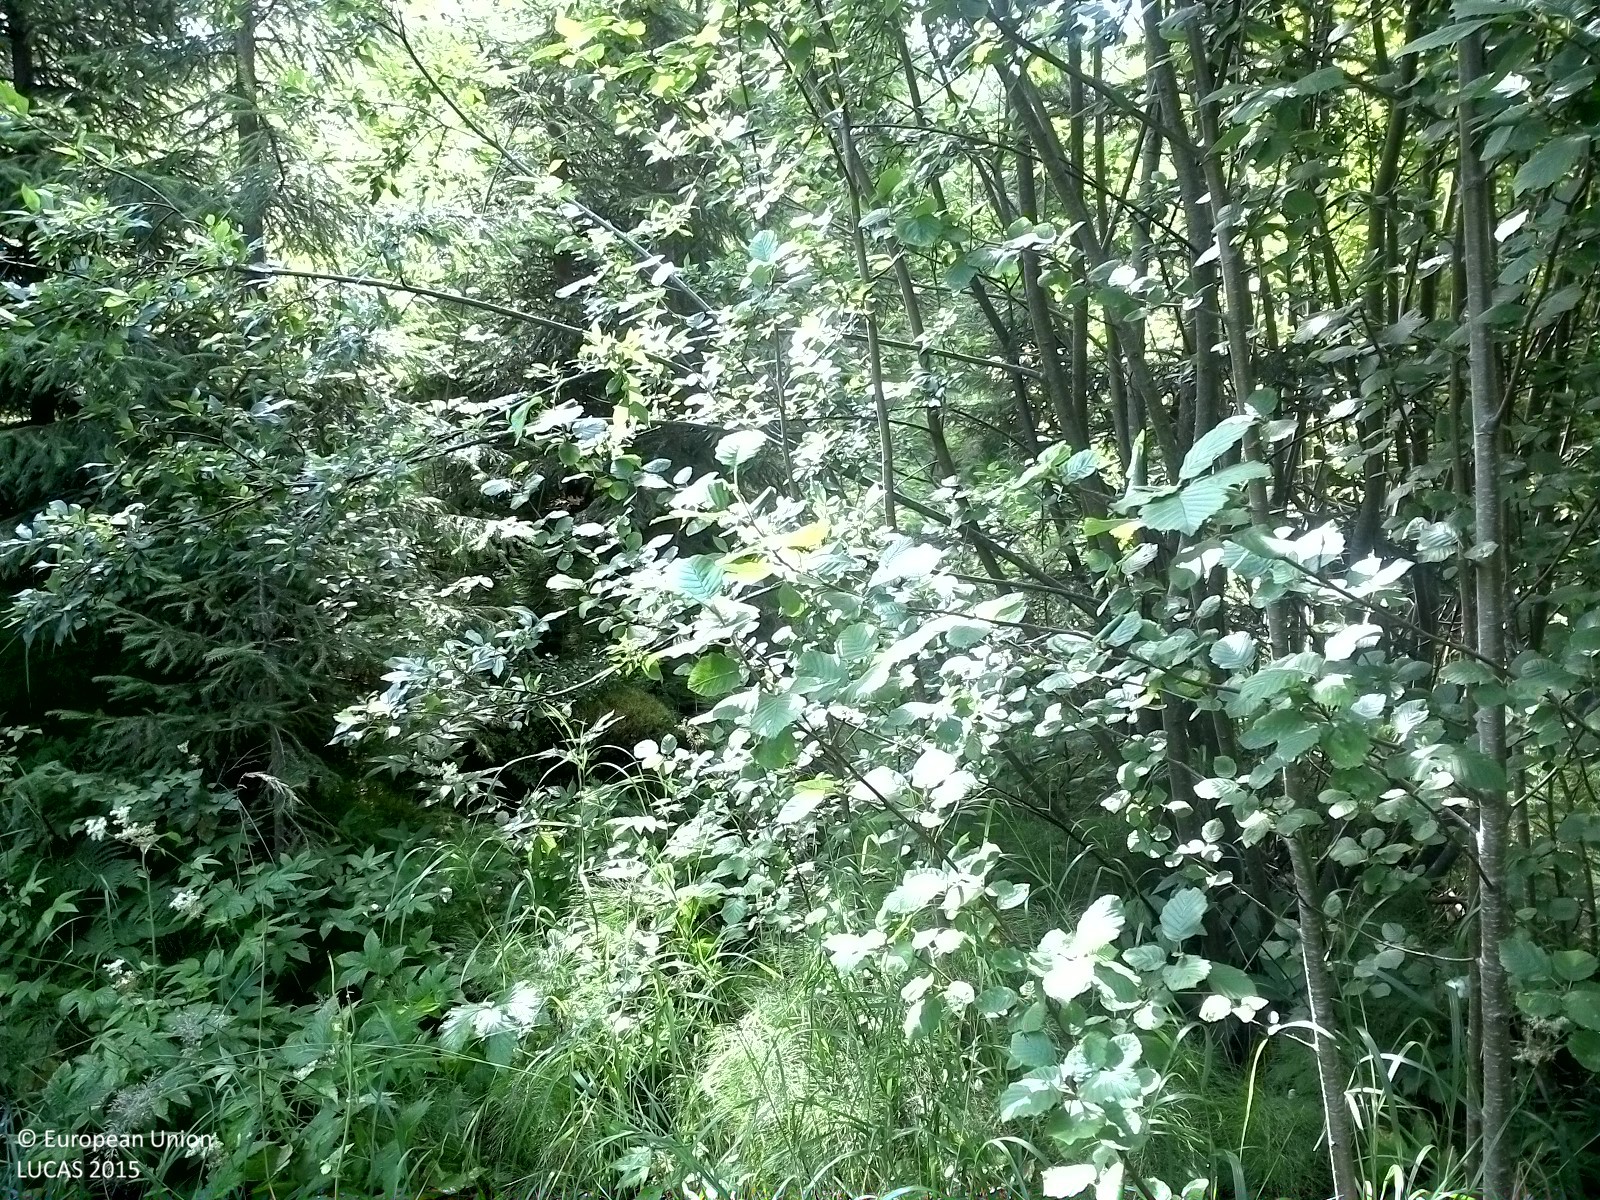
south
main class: Woodland
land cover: Other mixed woodland
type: boreal forest
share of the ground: 50 - 75 %
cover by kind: herbaceous plants 45 %, broadleaved forest trees 40 %, coniferous forest trees 15 %
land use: Semi-natural and natural areas not in use
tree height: < 5 m
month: August
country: SE
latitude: 62.5114
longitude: 17.2233
